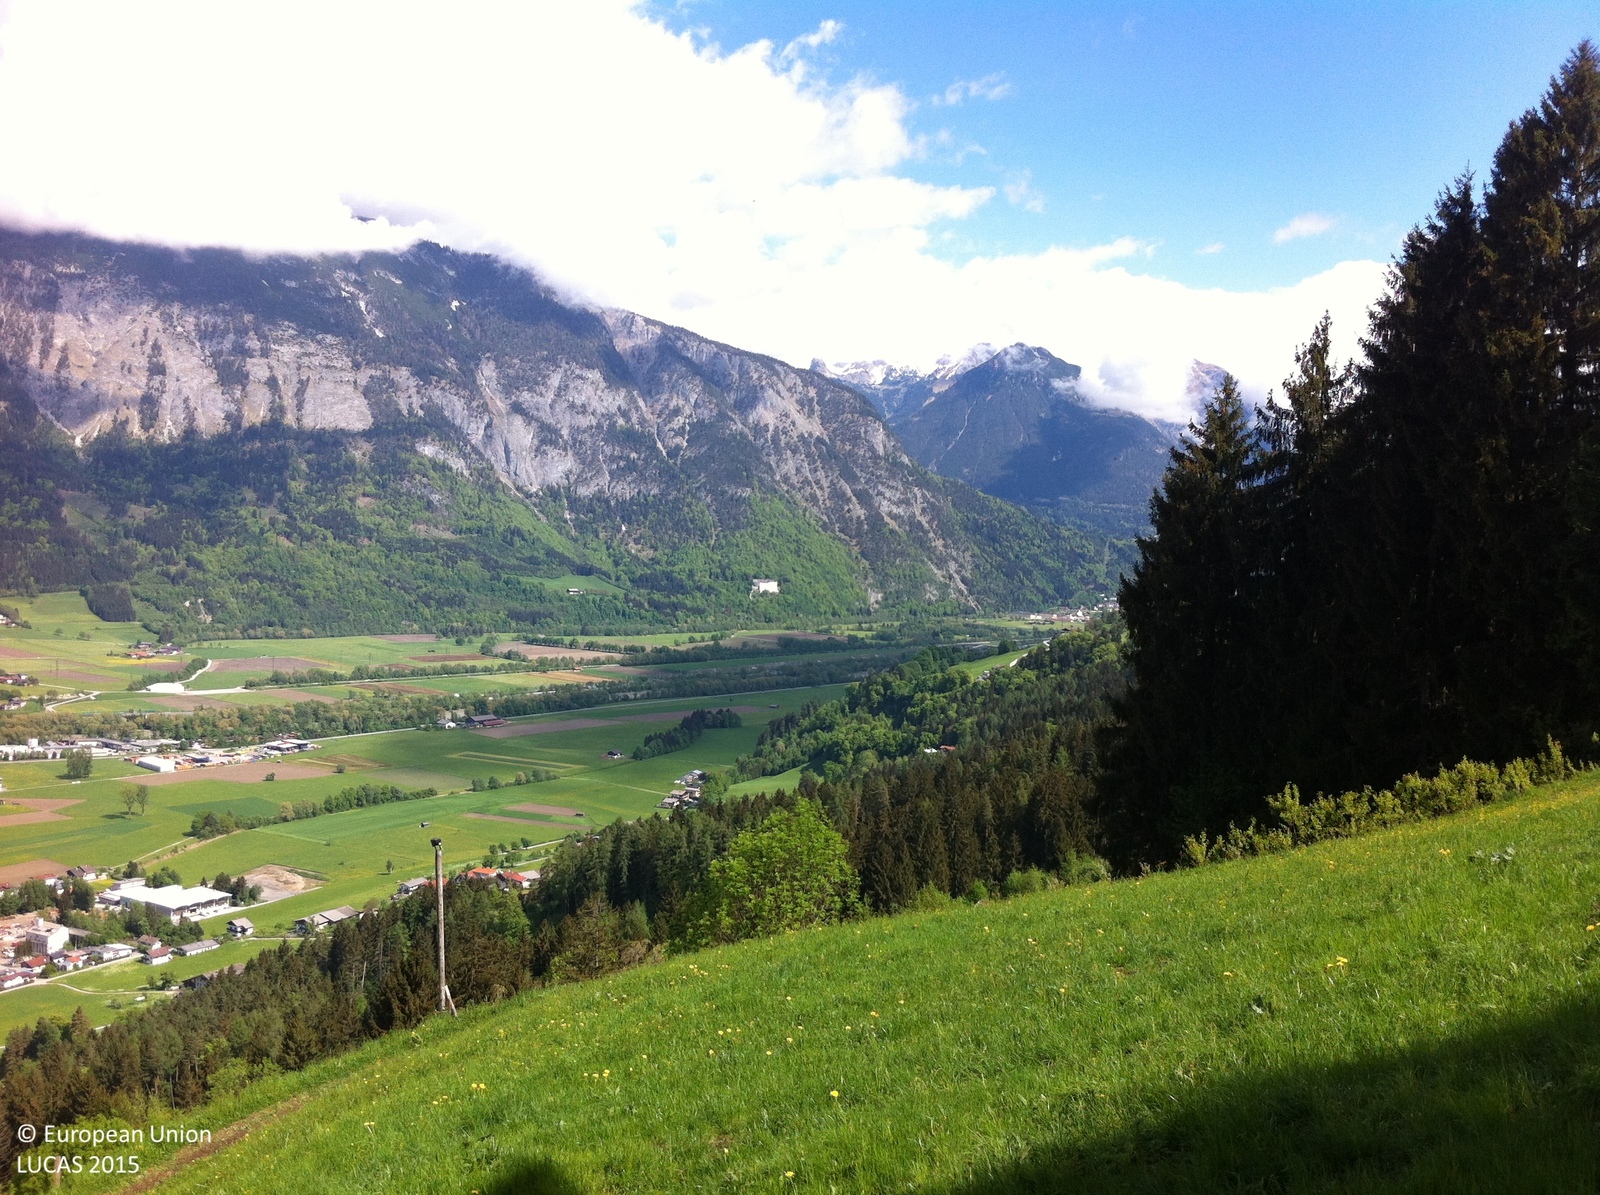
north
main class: Grassland
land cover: Grassland without tree/shrub cover
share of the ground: > 75 %
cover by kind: herbaceous plants 100 %
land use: Agriculture (excluding fallow land and kitchen gardens)
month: May
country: AT
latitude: 47.3458
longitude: 11.7325
